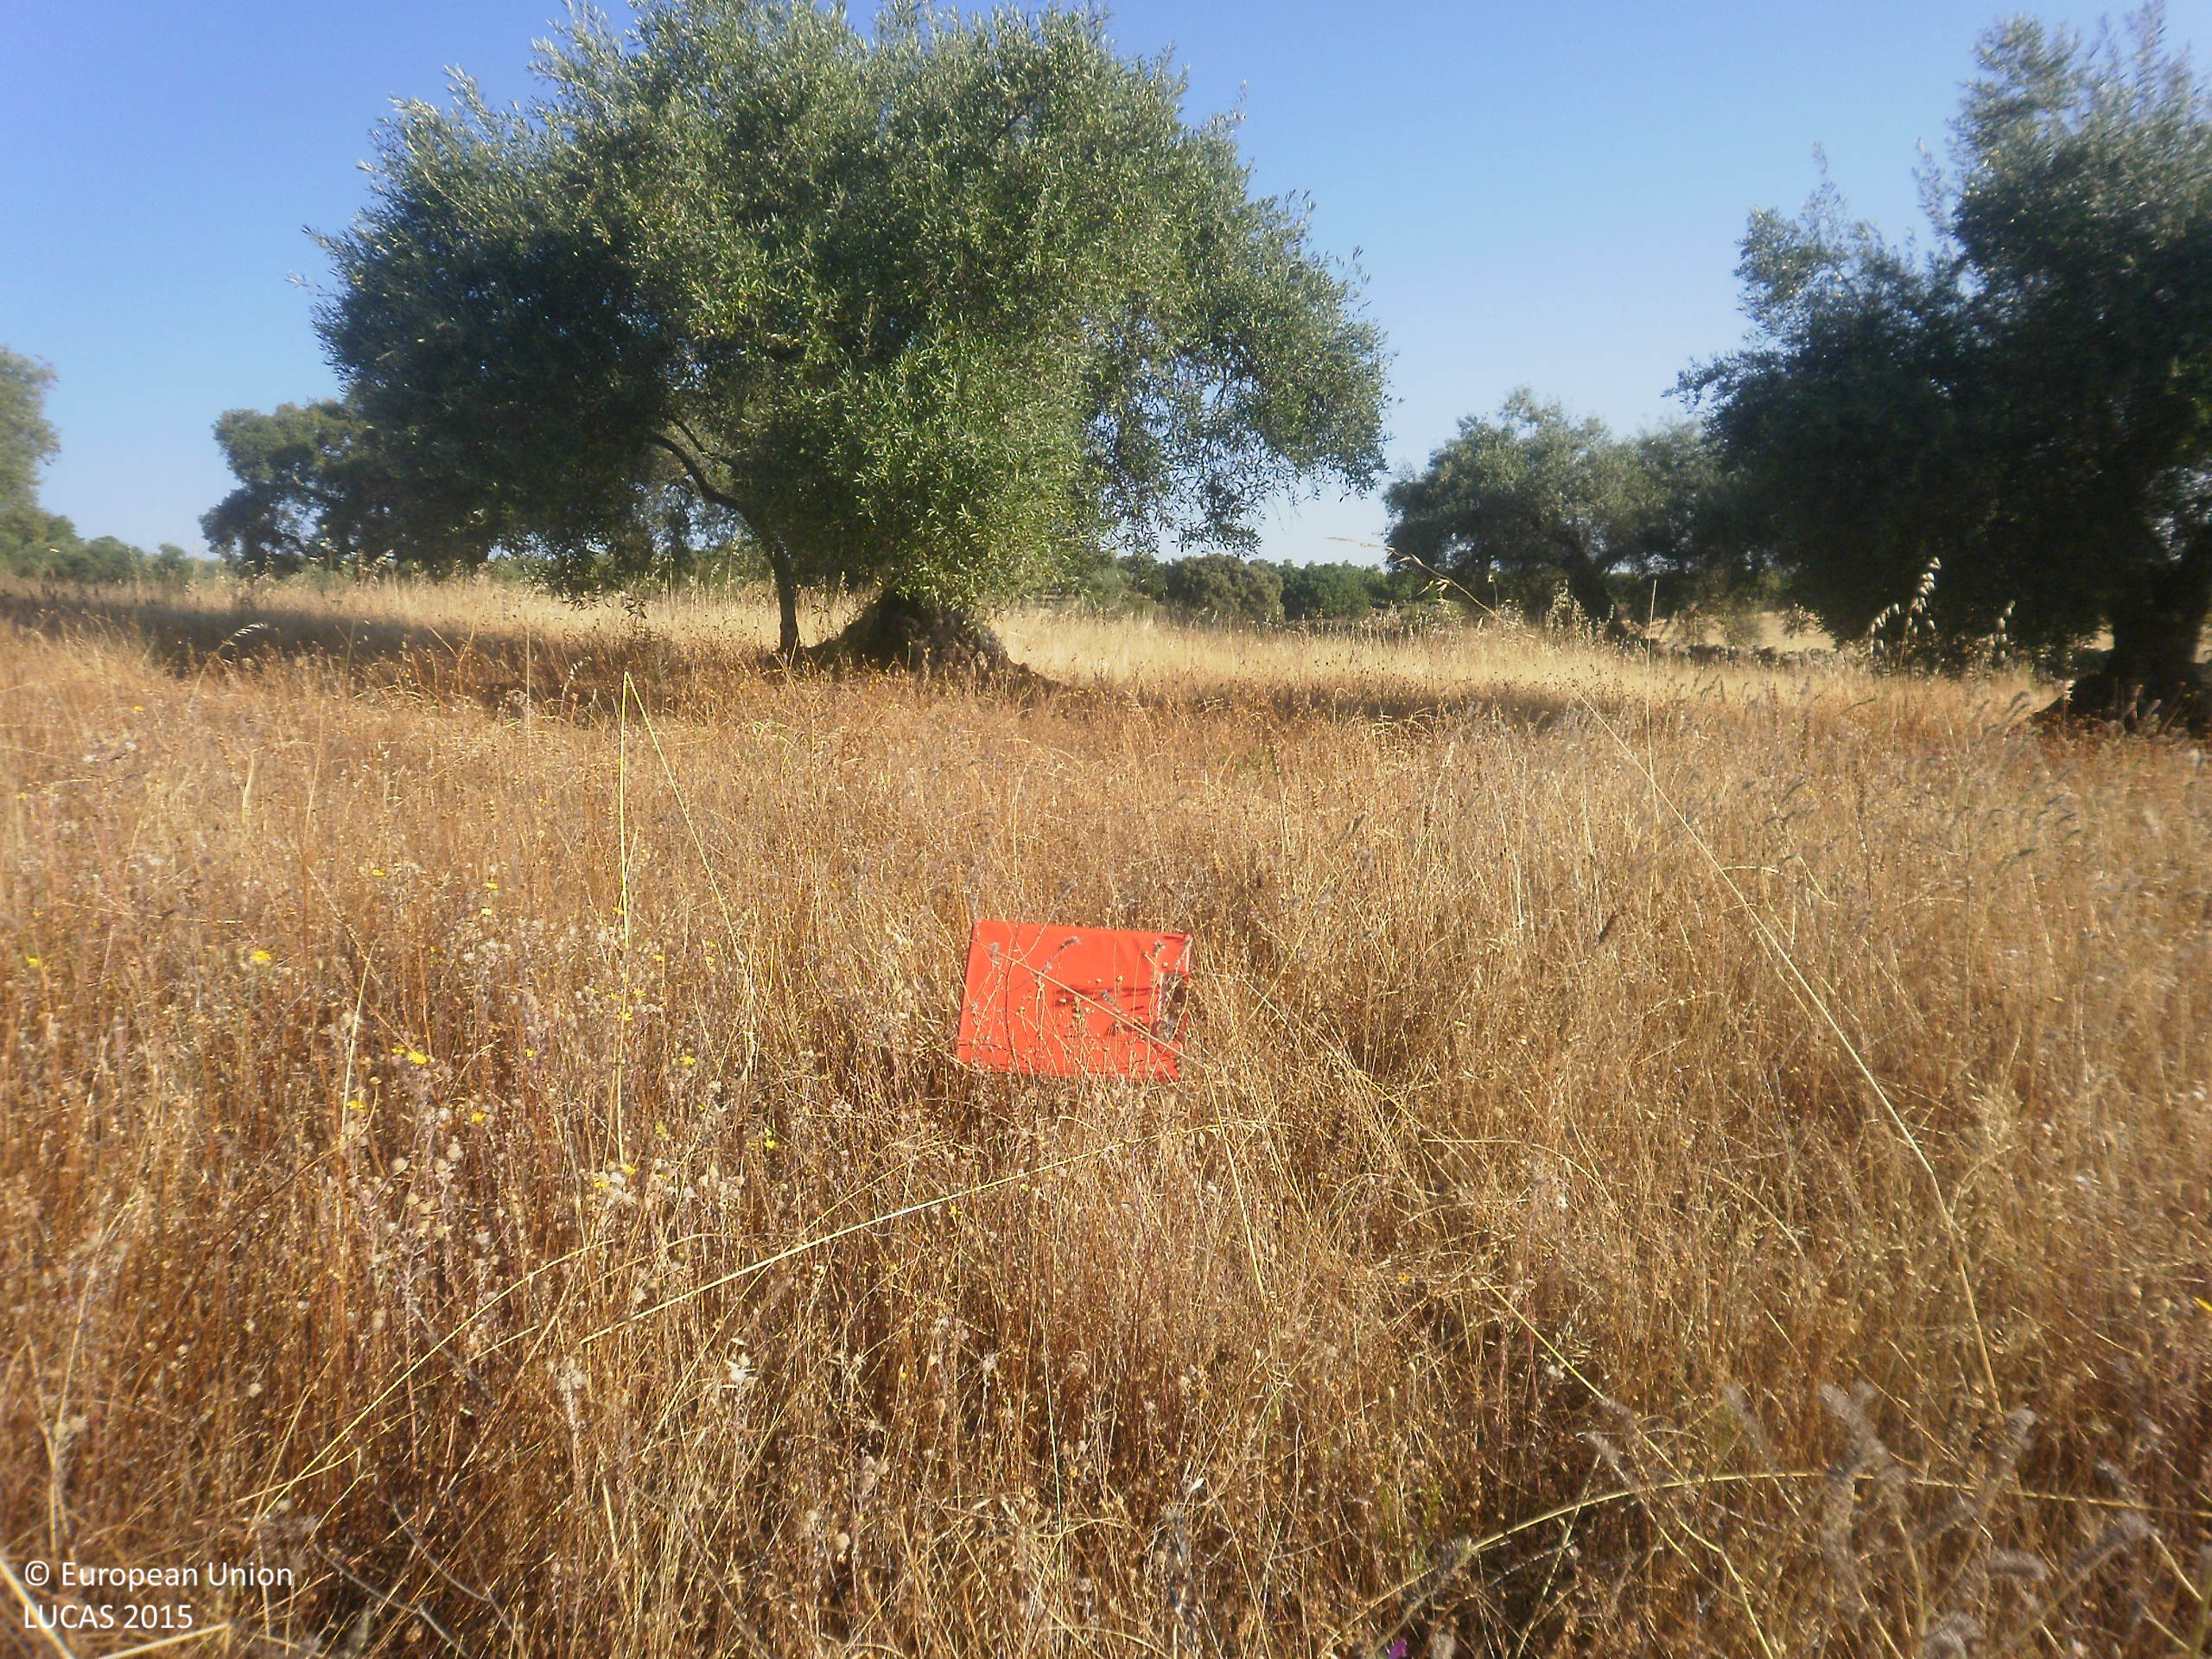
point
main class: Cropland
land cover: Olive groves
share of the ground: 50 - 75 %
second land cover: Grassland without tree/shrub cover
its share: 25 - 50 %
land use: Agriculture (excluding fallow land and kitchen gardens)
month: June
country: ES
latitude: 39.2513
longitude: -6.0371
